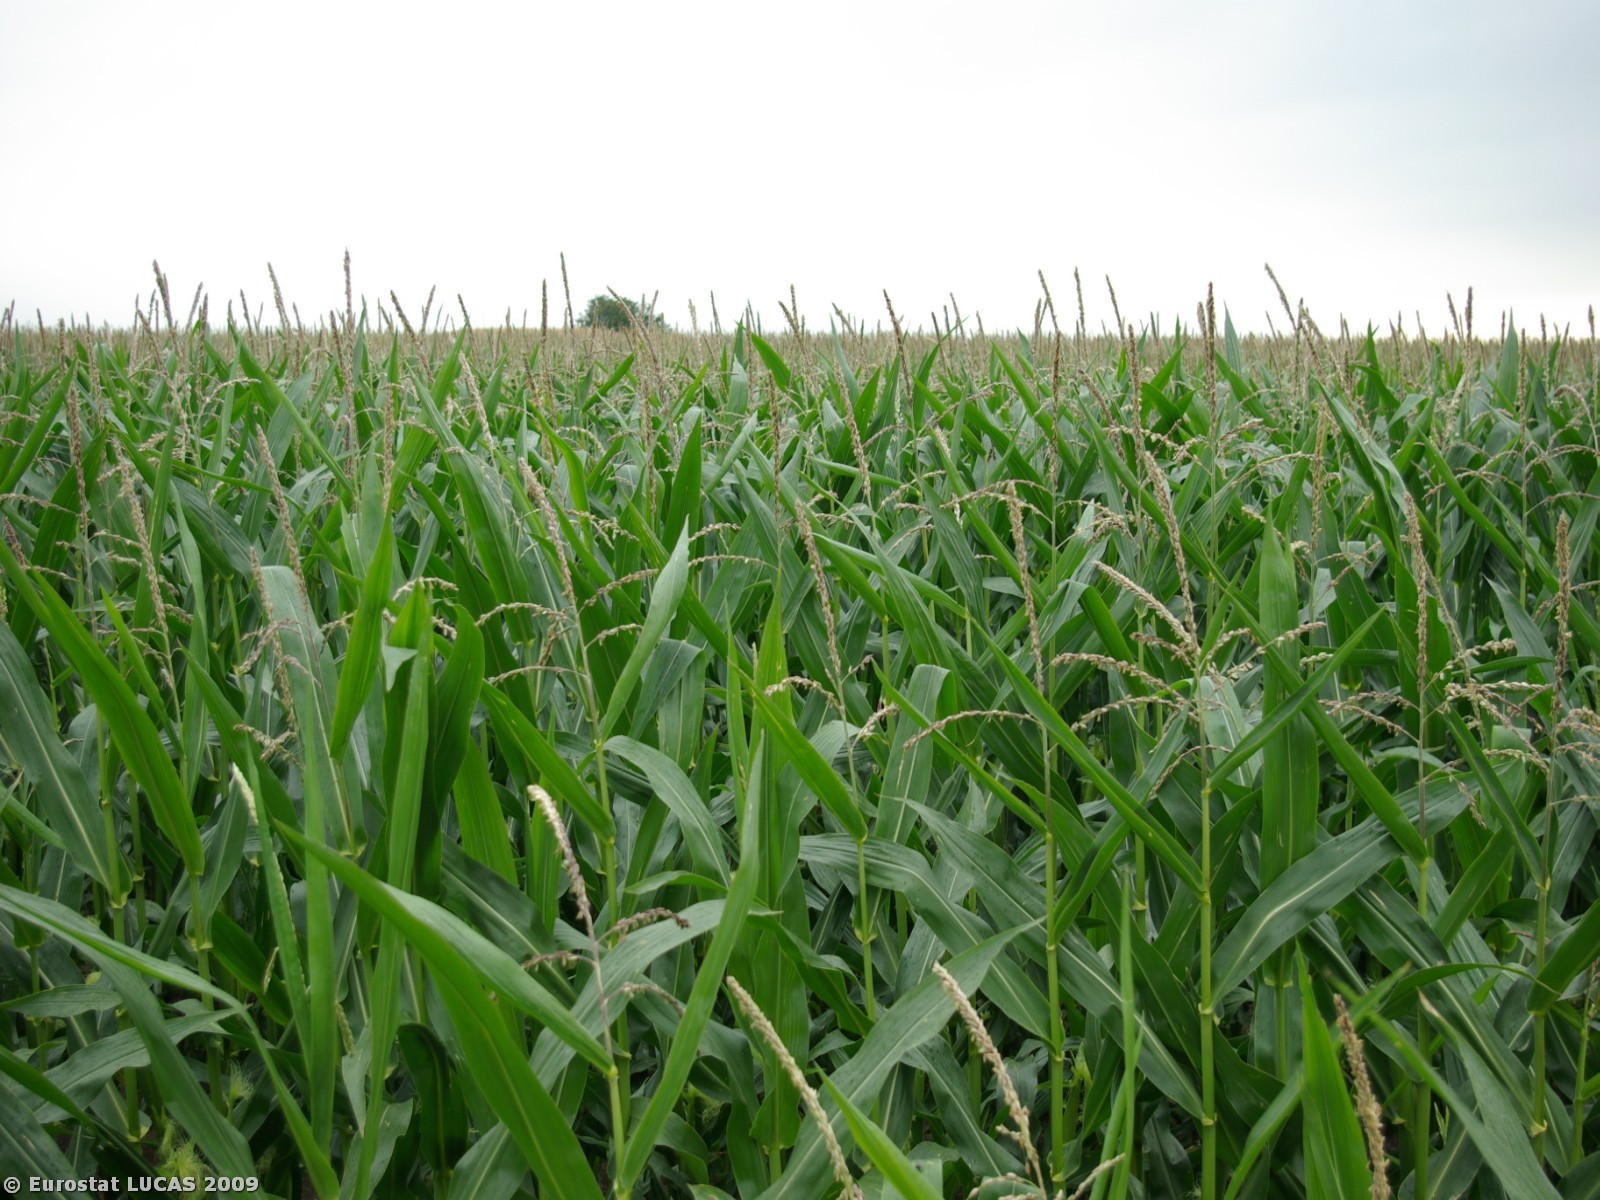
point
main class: Cropland
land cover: Maize
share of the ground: > 75 %
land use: Agriculture (excluding fallow land and kitchen gardens)
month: July
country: DK
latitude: 55.1574
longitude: 8.7925
